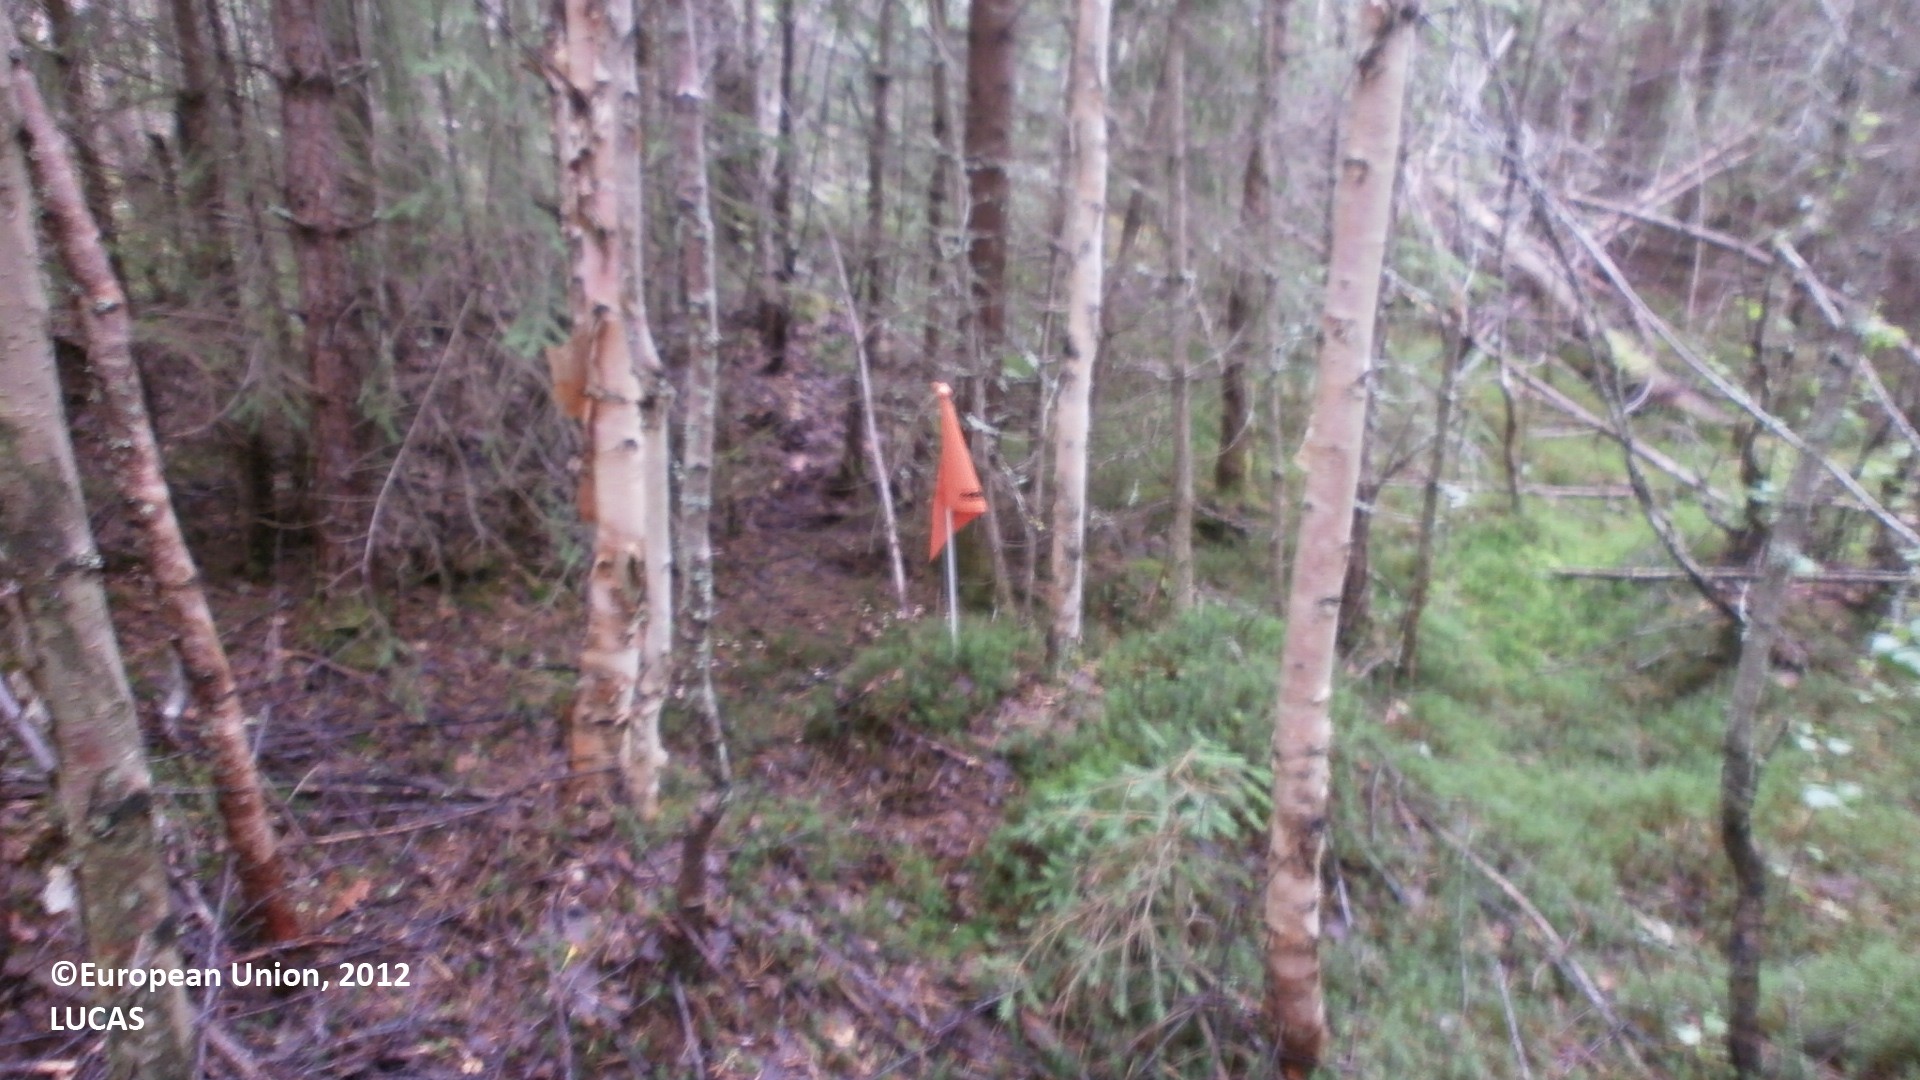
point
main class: Woodland
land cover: Pine dominated mixed woodland
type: boreal forest
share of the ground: > 75 %
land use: Forestry
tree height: > 5 m
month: July
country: FI
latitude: 64.7443
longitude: 24.6688
